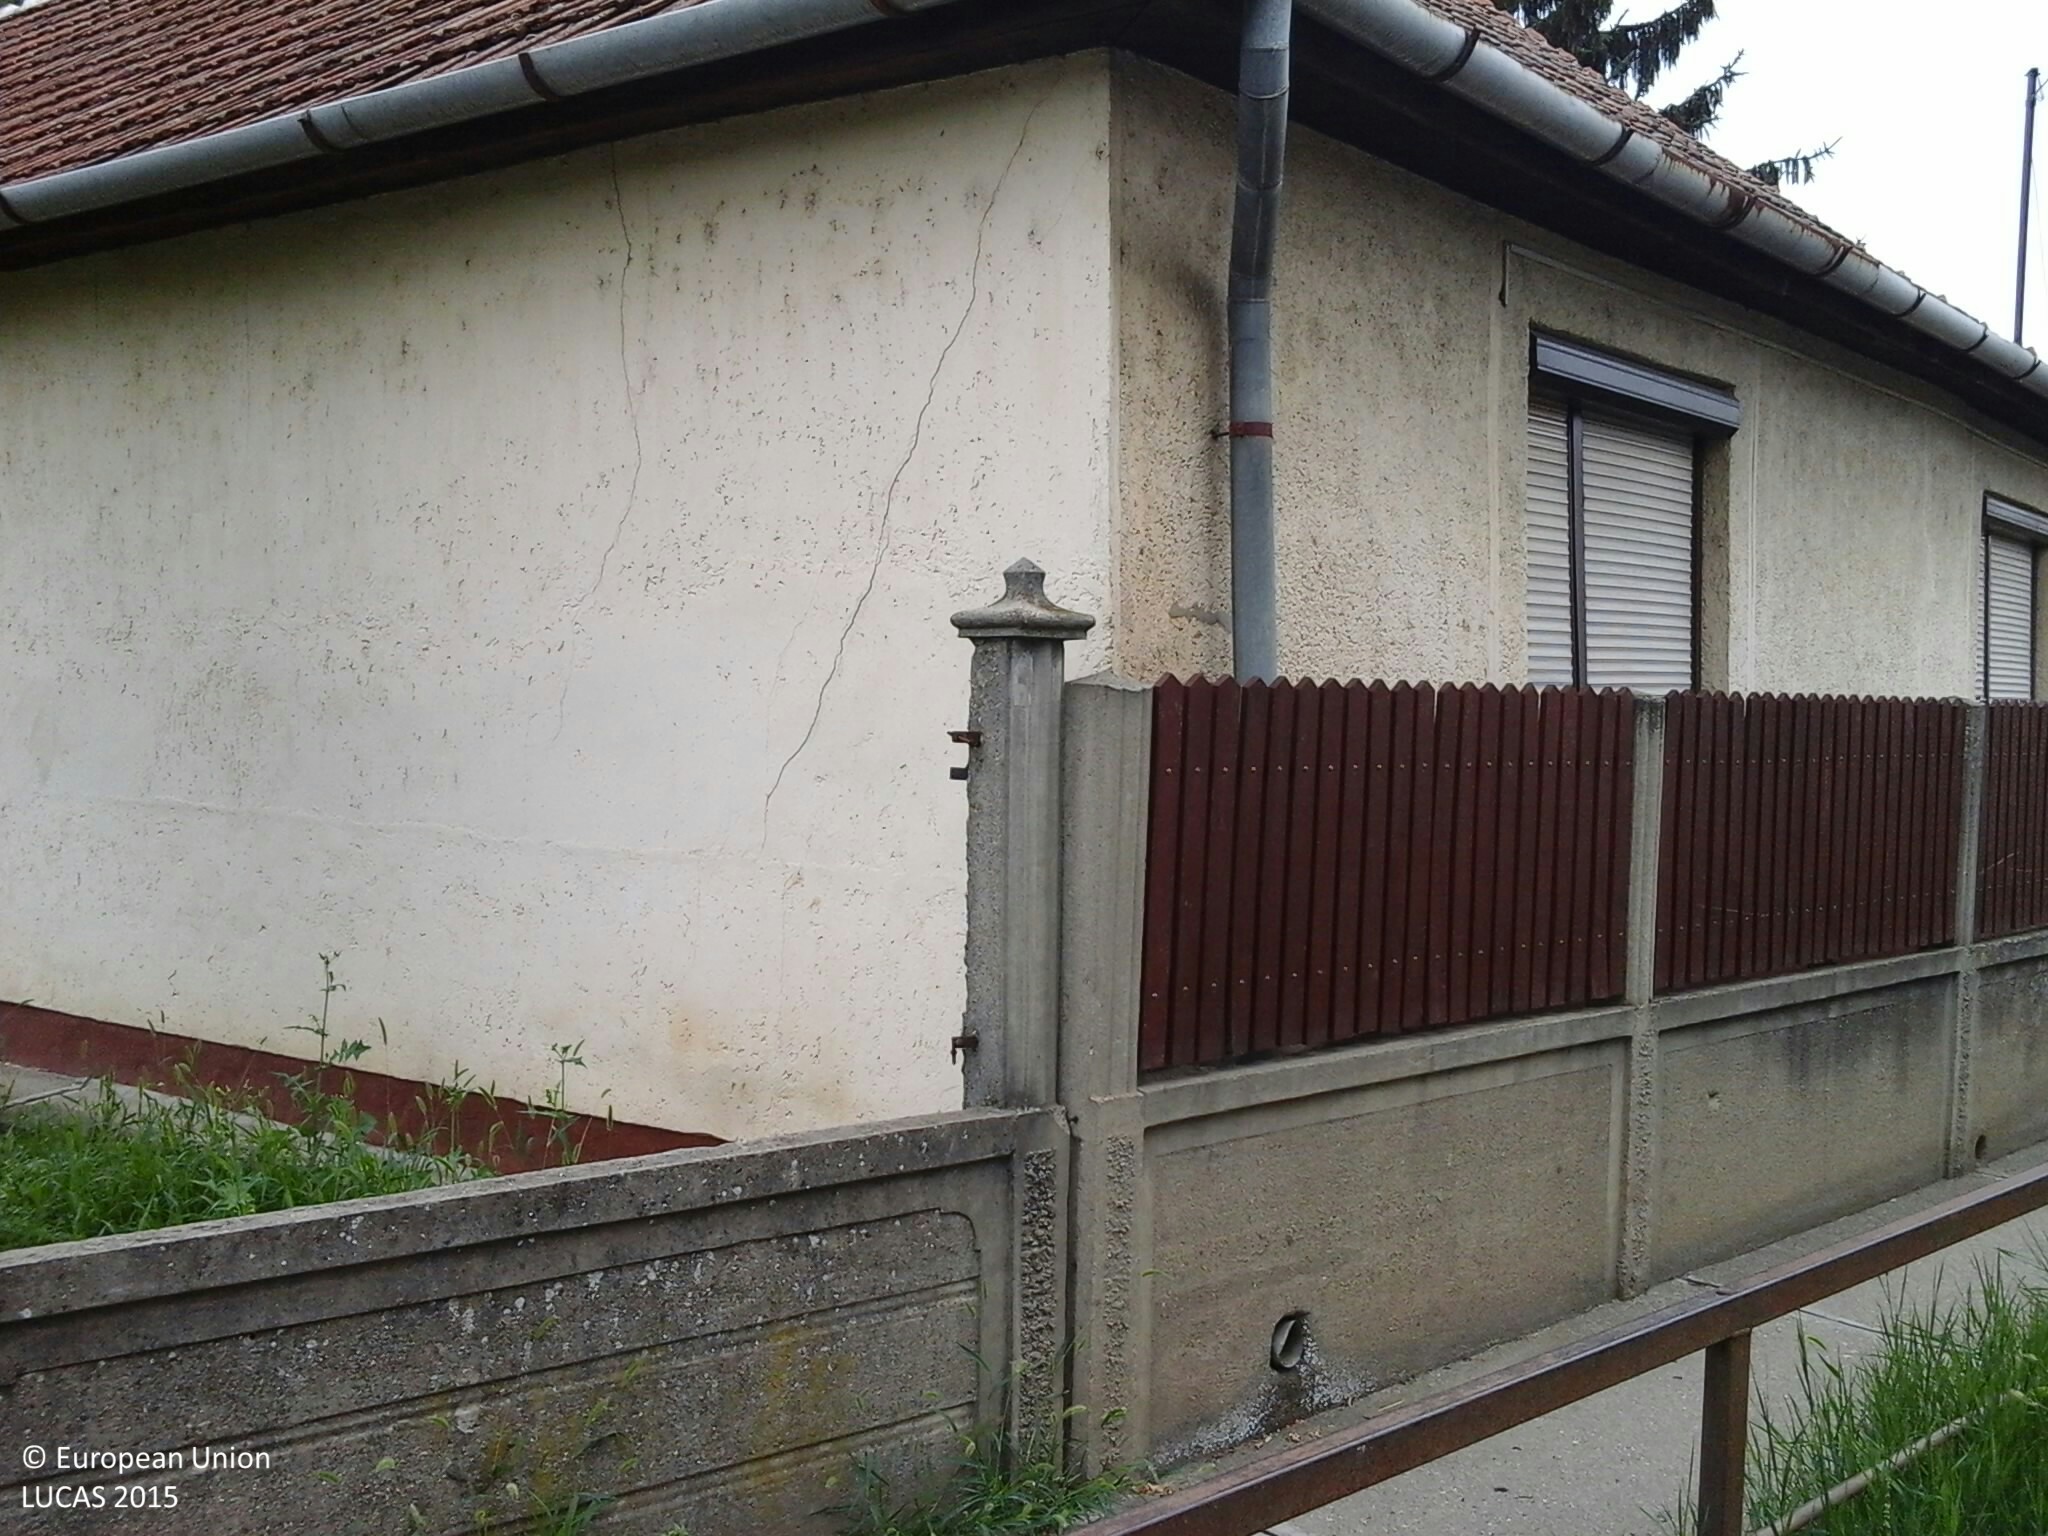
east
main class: Grassland
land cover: Grassland without tree/shrub cover
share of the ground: > 75 %
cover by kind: herbaceous plants 100 %
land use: Residential
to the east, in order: Grassland without tree/shrub cover; Artificial constructions in urban areas
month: July
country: HU
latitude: 47.8204
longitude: 21.4907
